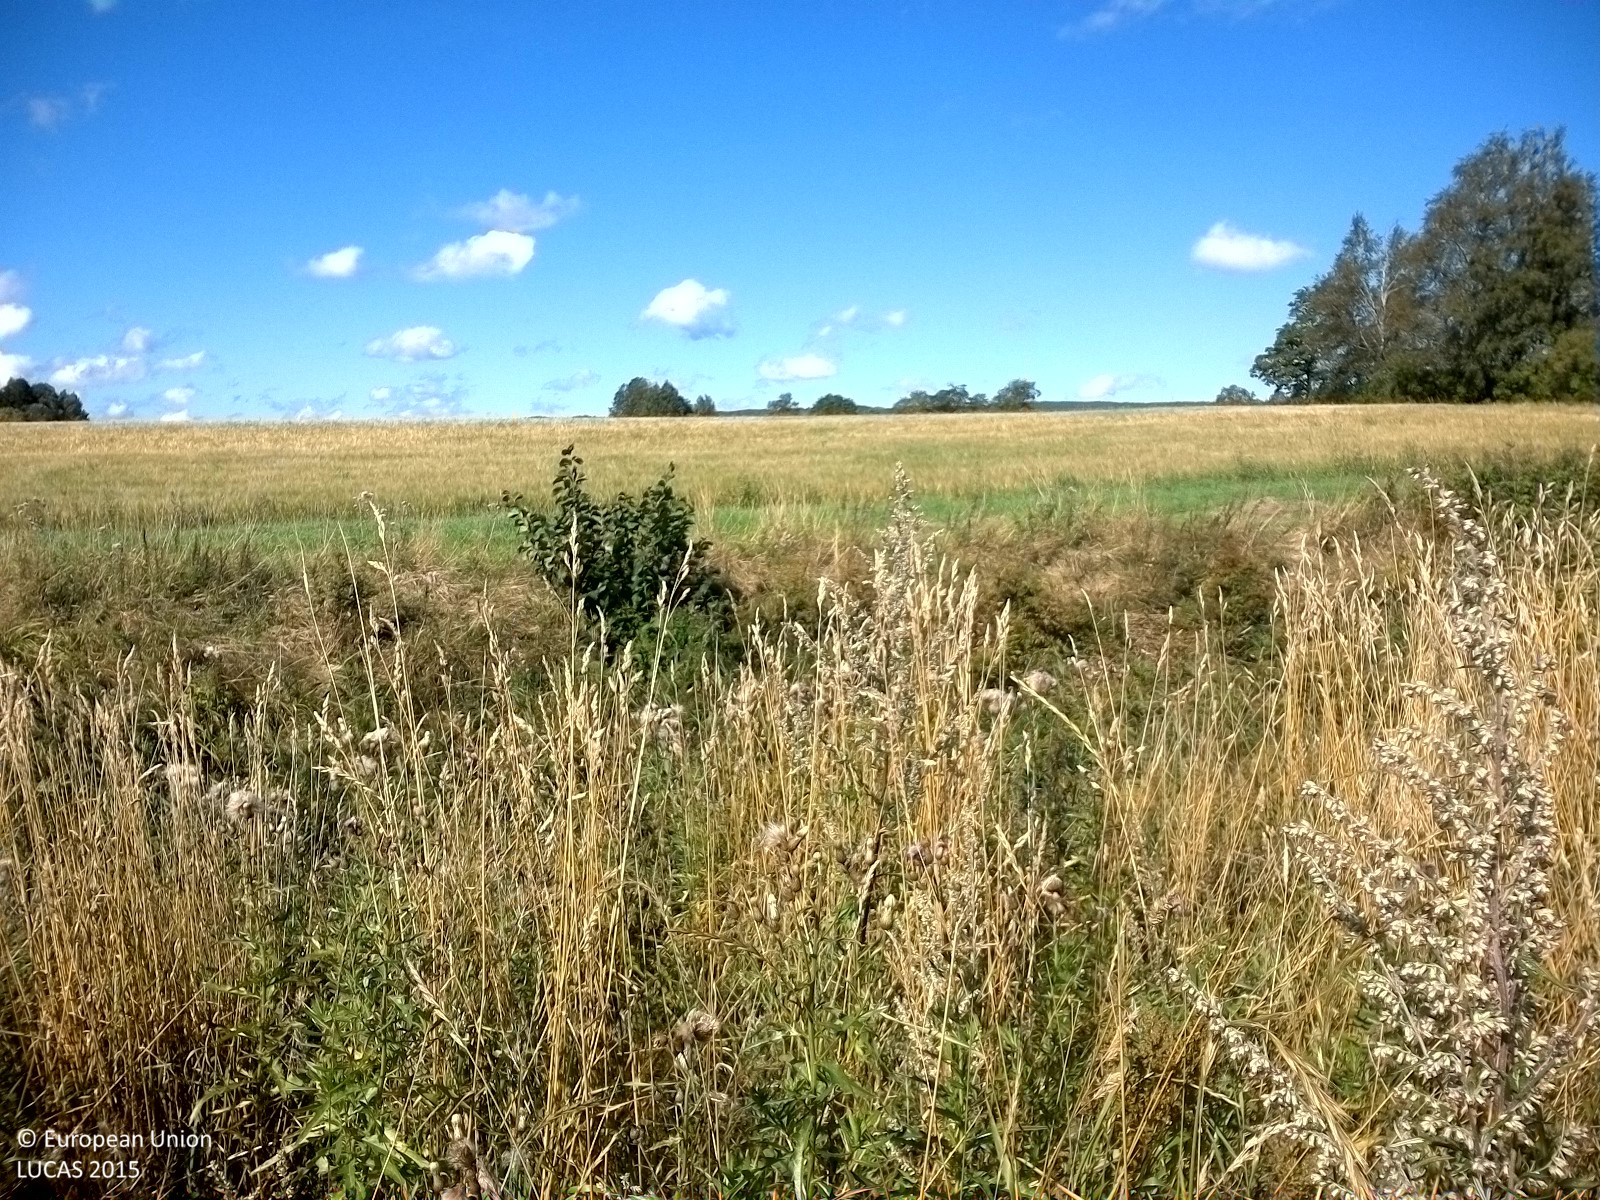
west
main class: Grassland
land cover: Grassland without tree/shrub cover
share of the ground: > 75 %
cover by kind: herbaceous plants 100 %
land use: Agriculture (excluding fallow land and kitchen gardens)
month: August
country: SE
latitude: 59.3678
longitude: 15.0764
